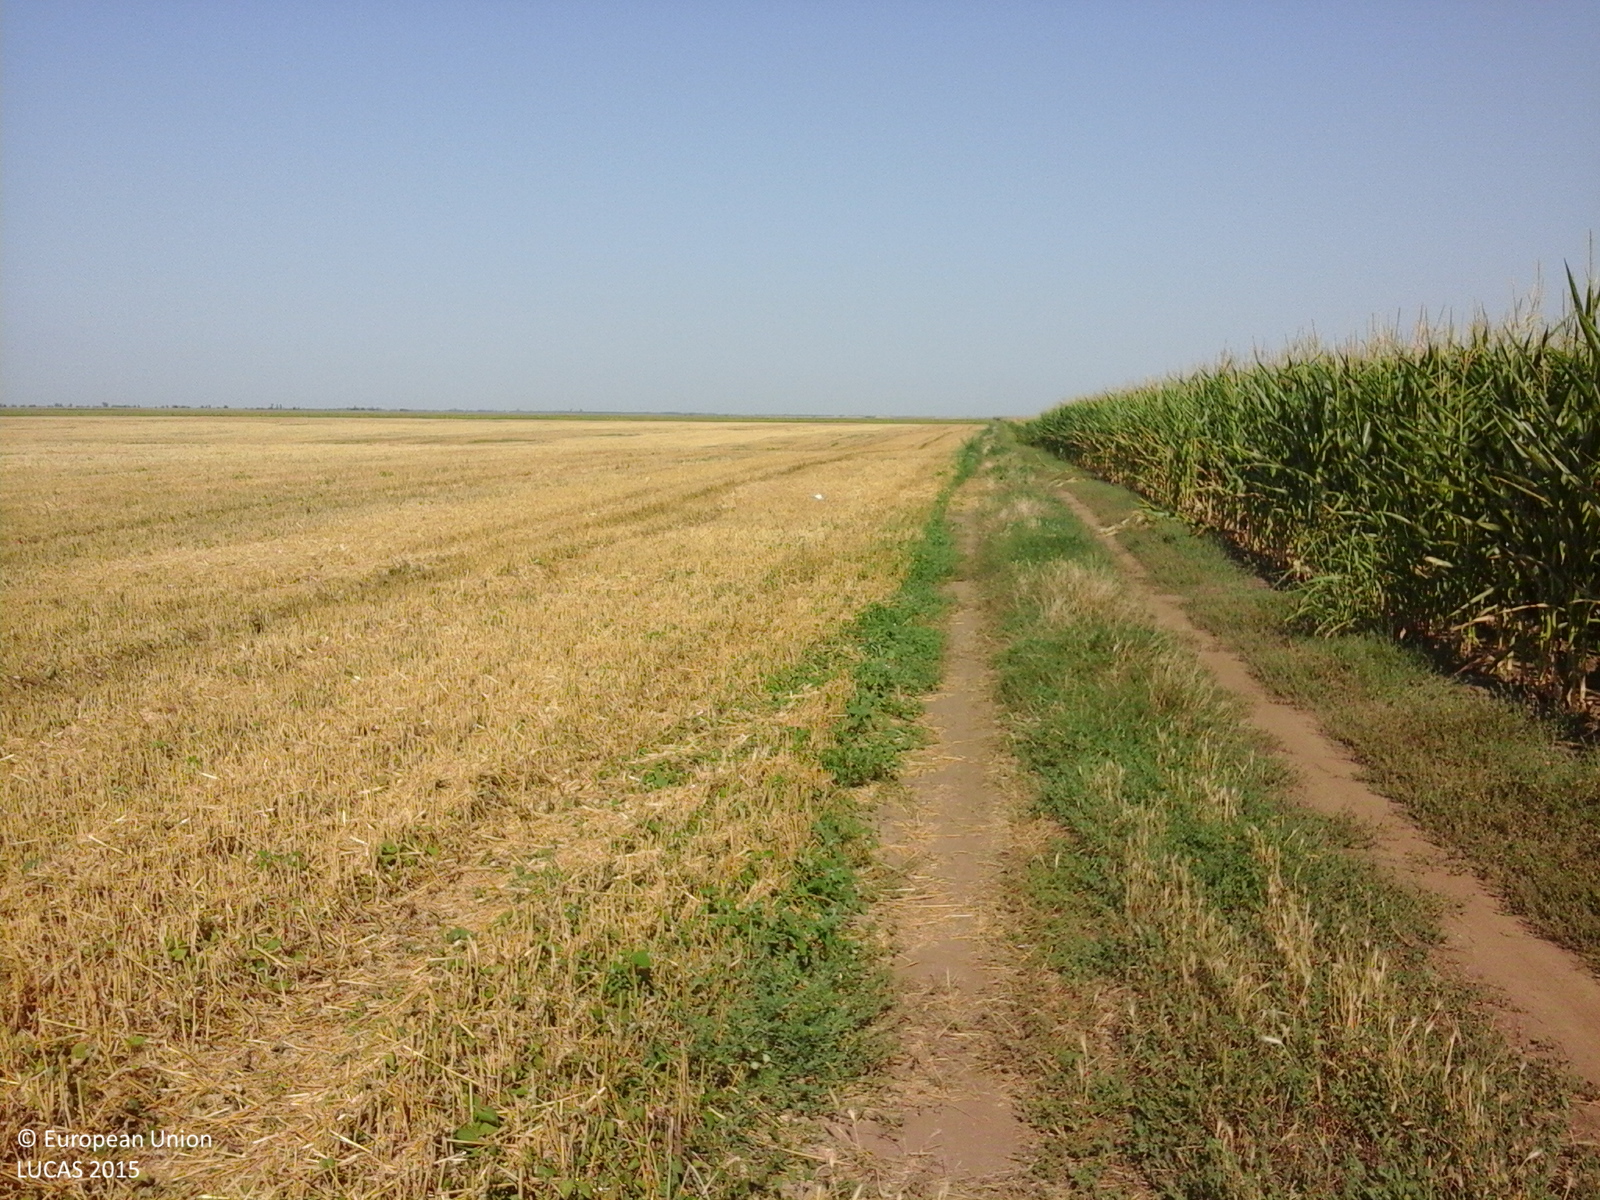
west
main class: Cropland
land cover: Maize
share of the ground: > 75 %
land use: Agriculture (excluding fallow land and kitchen gardens)
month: July
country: RO
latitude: 44.7585
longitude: 27.1004
